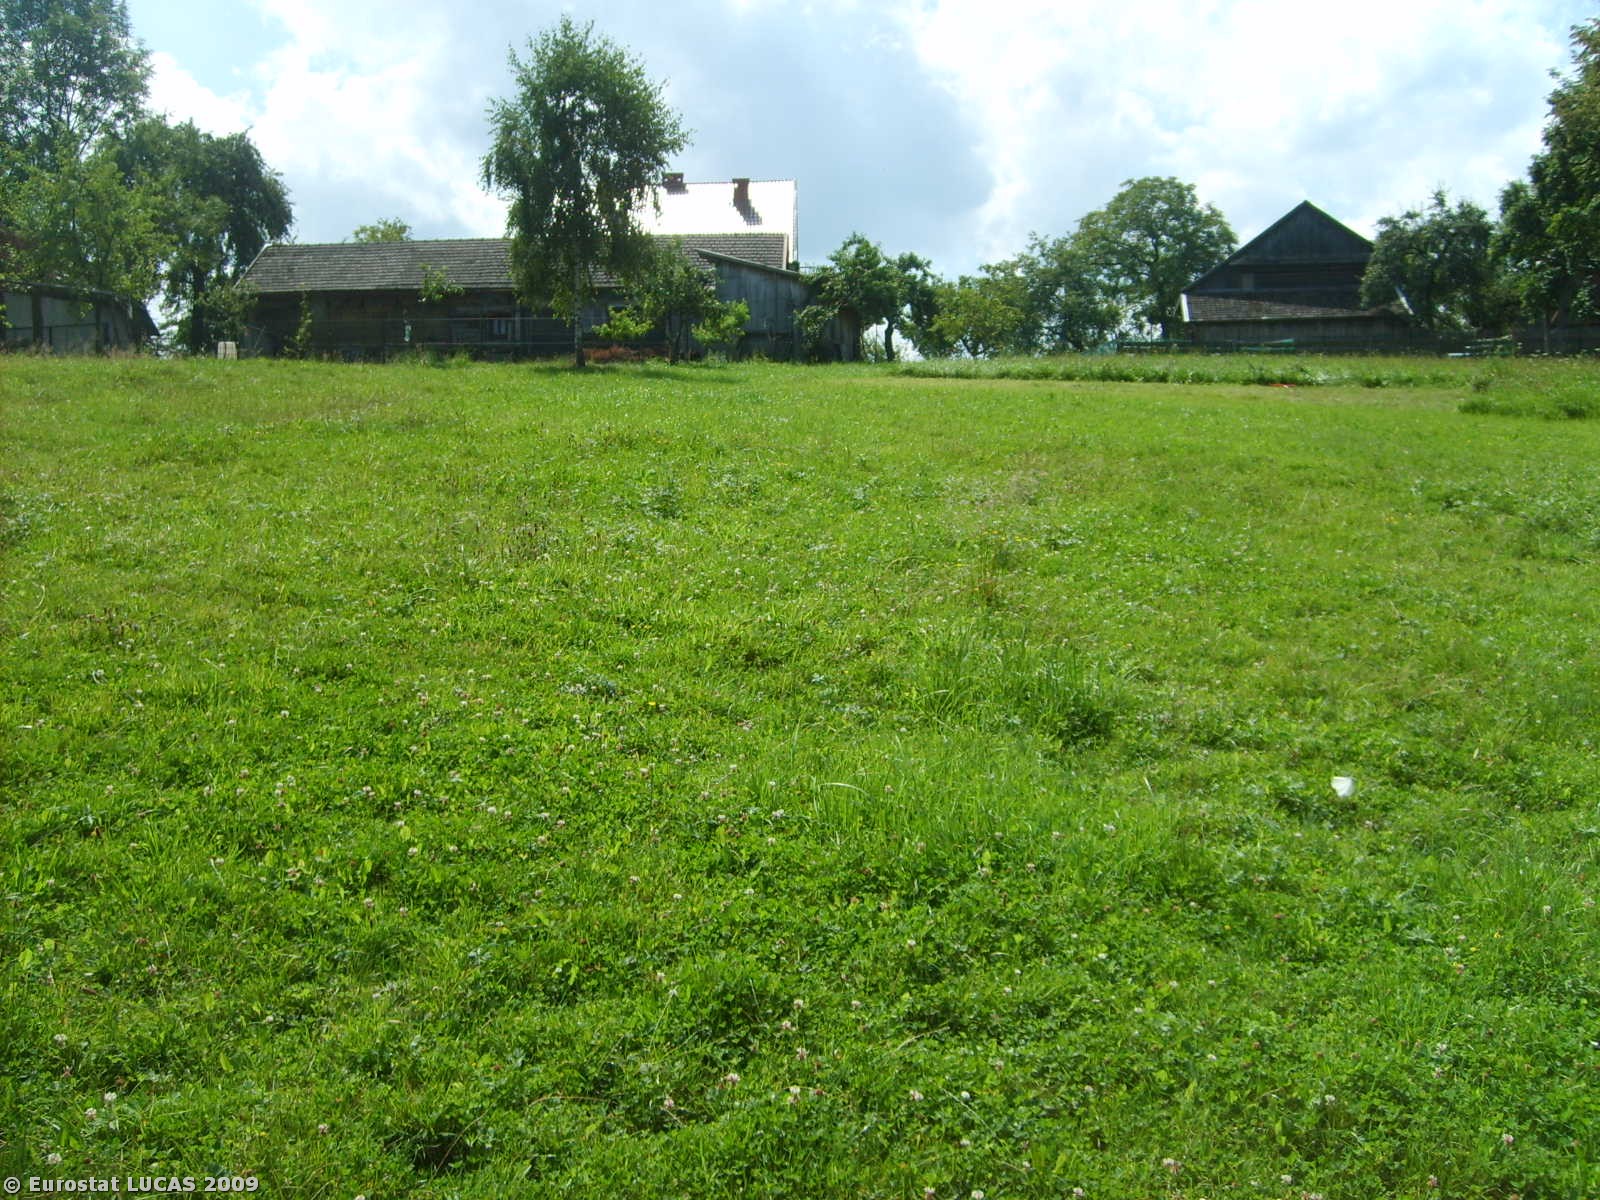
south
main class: Grassland
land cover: Grassland without tree/shrub cover
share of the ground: > 75 %
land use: Agriculture (excluding fallow land and kitchen gardens)
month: July
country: PL
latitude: 49.8627
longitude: 20.4847
